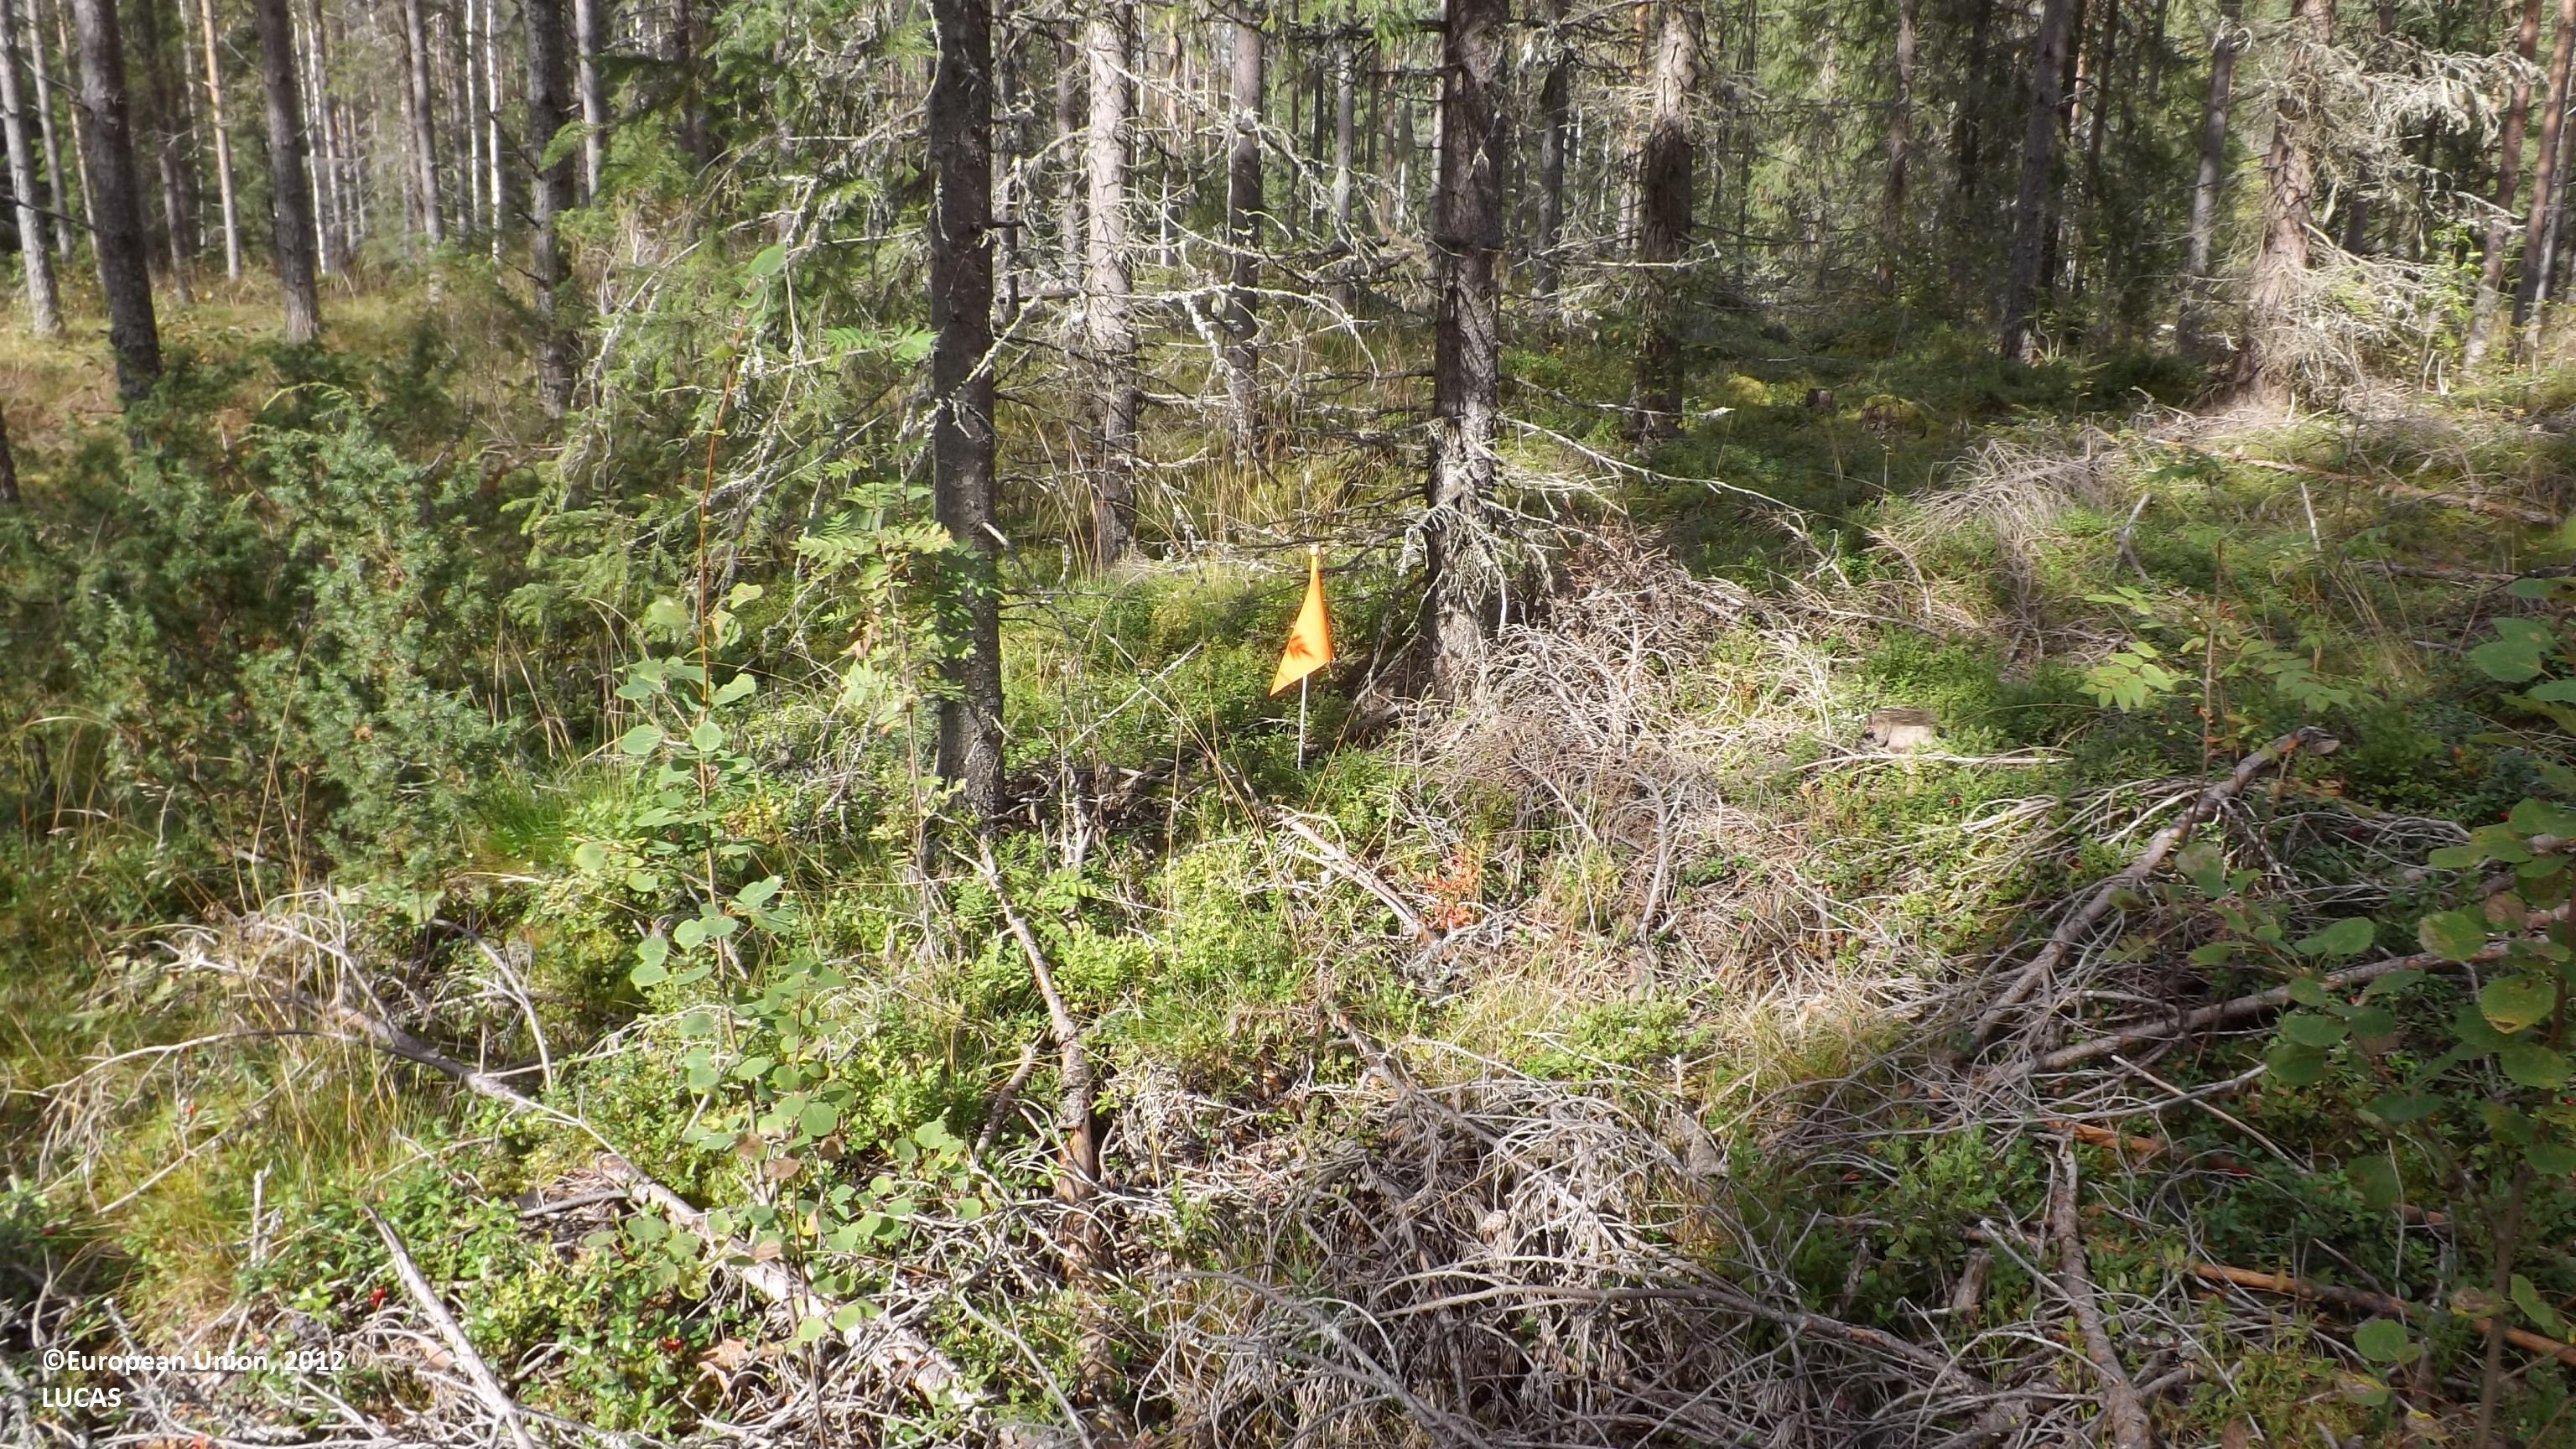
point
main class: Woodland
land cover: Pine dominated mixed woodland
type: boreal forest
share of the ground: 50 - 75 %
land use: Forestry
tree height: > 5 m
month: August
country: FI
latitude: 63.7099
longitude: 23.4762
